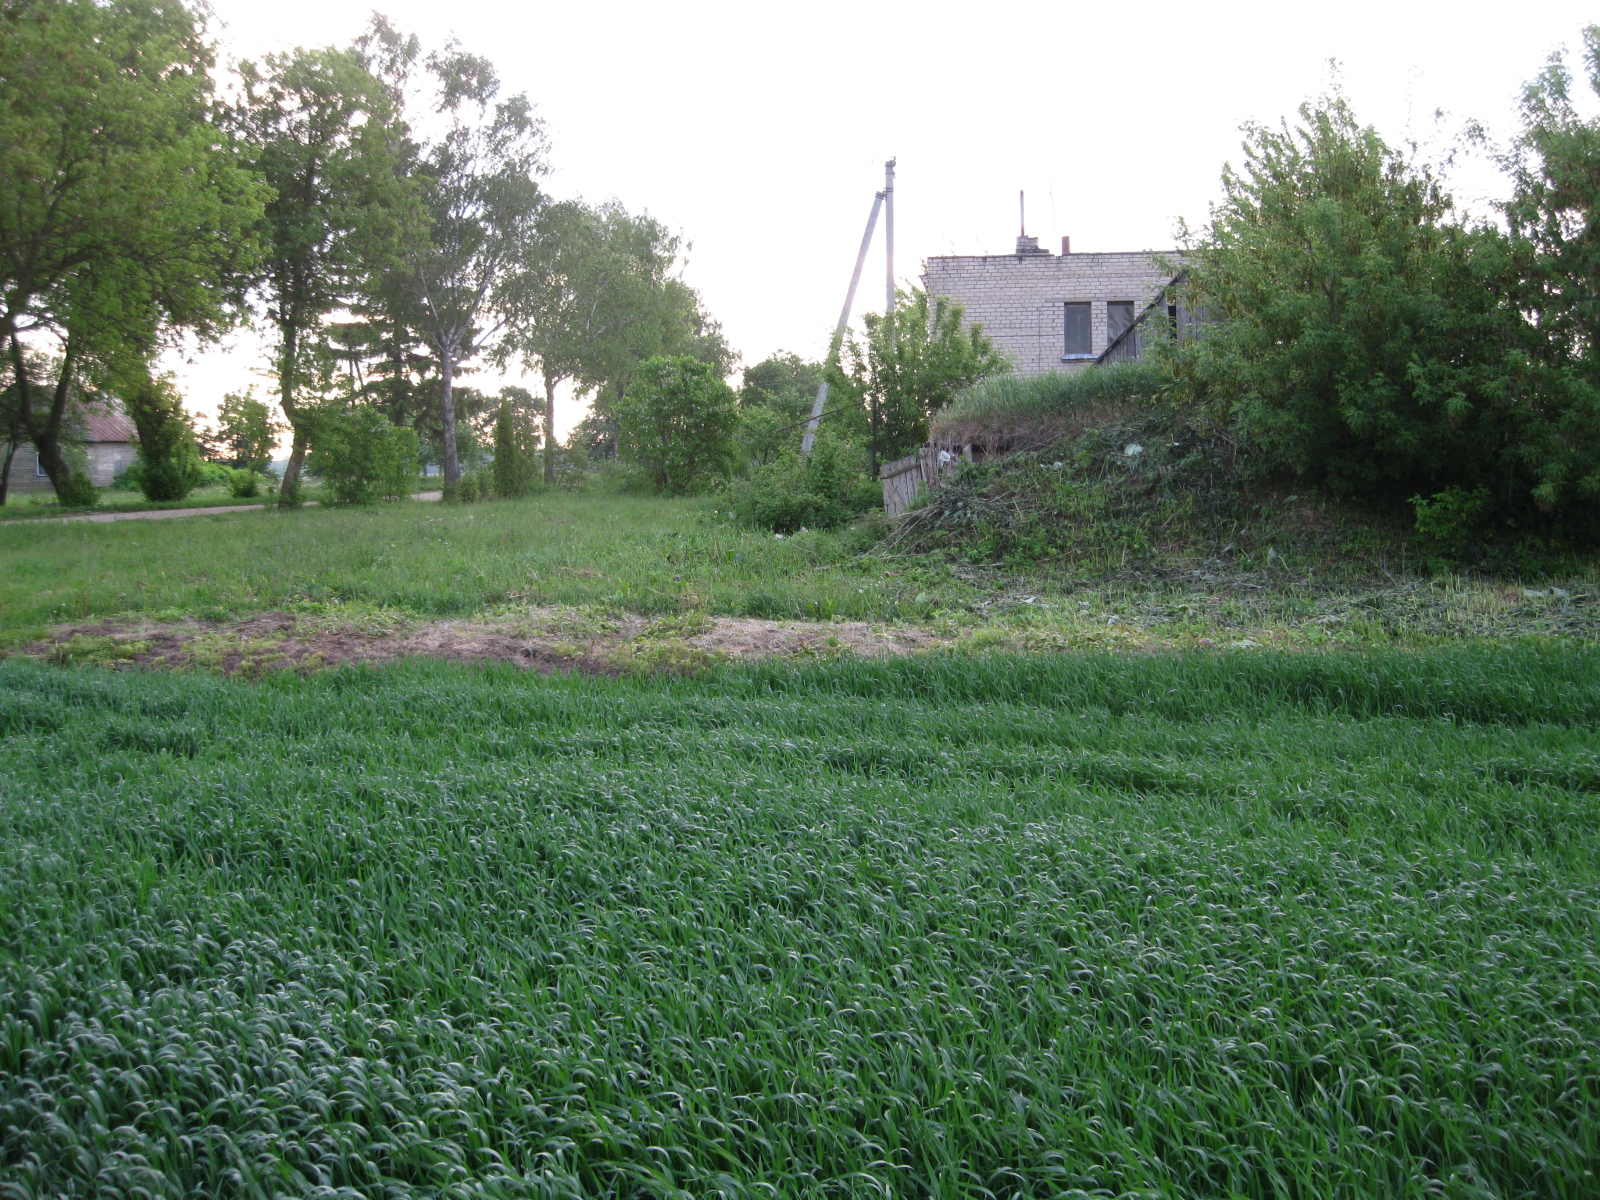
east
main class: Cropland
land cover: Common wheat
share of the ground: > 75 %
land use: Agriculture (excluding fallow land and kitchen gardens)
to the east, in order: Common wheat; Spontaneously vegetated surfaces; Artificial constructions in urban areas; Grassland without tree/shrub cover; Electric lines; Grassland without tree/shrub cover; Common wheat; Broadleaved woodland; Paved roads, cycling and walking lanes; Lines of trees; Spontaneously vegetated surfaces; Broadleaved woodland; Spontaneously vegetated surfaces; Sugar beet
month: June
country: LT
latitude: 55.7236
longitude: 24.0197
